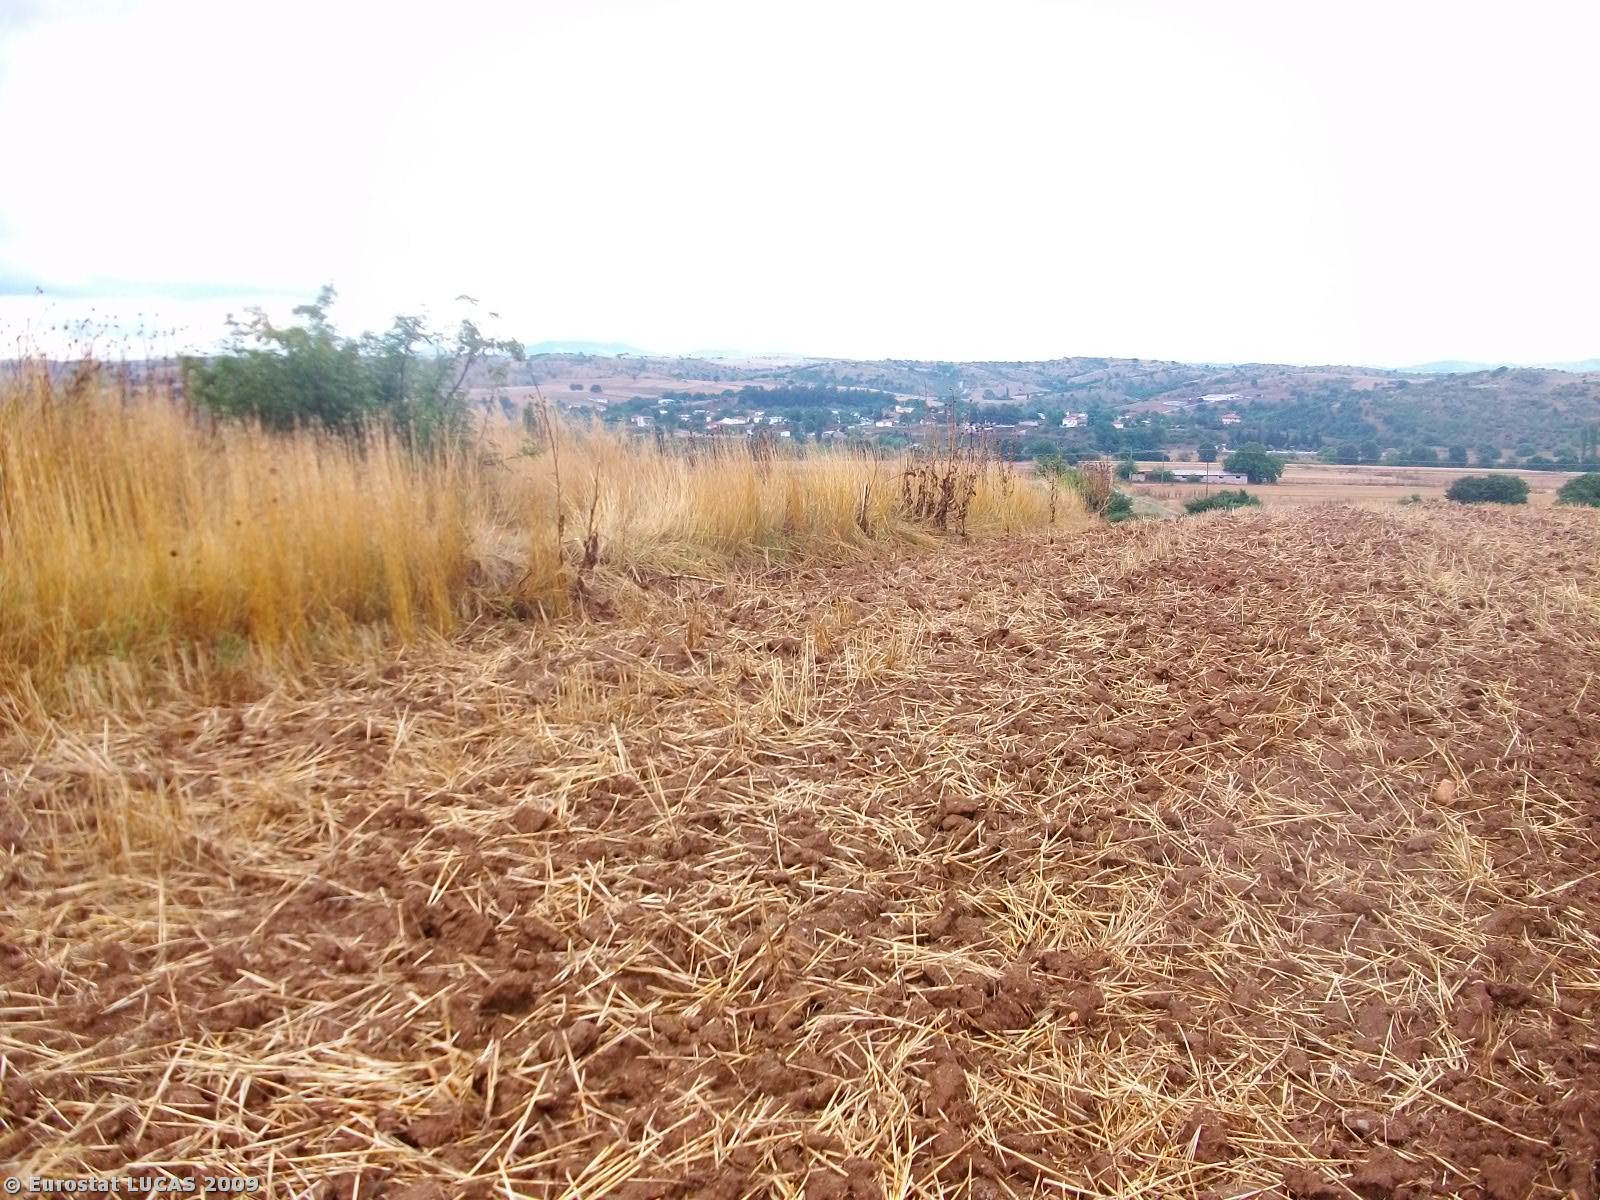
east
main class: Cropland
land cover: Barley
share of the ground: < 10 %
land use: Agriculture (excluding fallow land and kitchen gardens)
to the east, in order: Barley; Grass margins; Paved roads, cycling and walking lanes; Grass margins; Durum wheat; Grass margins; Paved roads, cycling and walking lanes; Broadleaved woodland; Durum wheat; Shruby margins
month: June
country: GR
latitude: 40.9808
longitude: 22.9300
